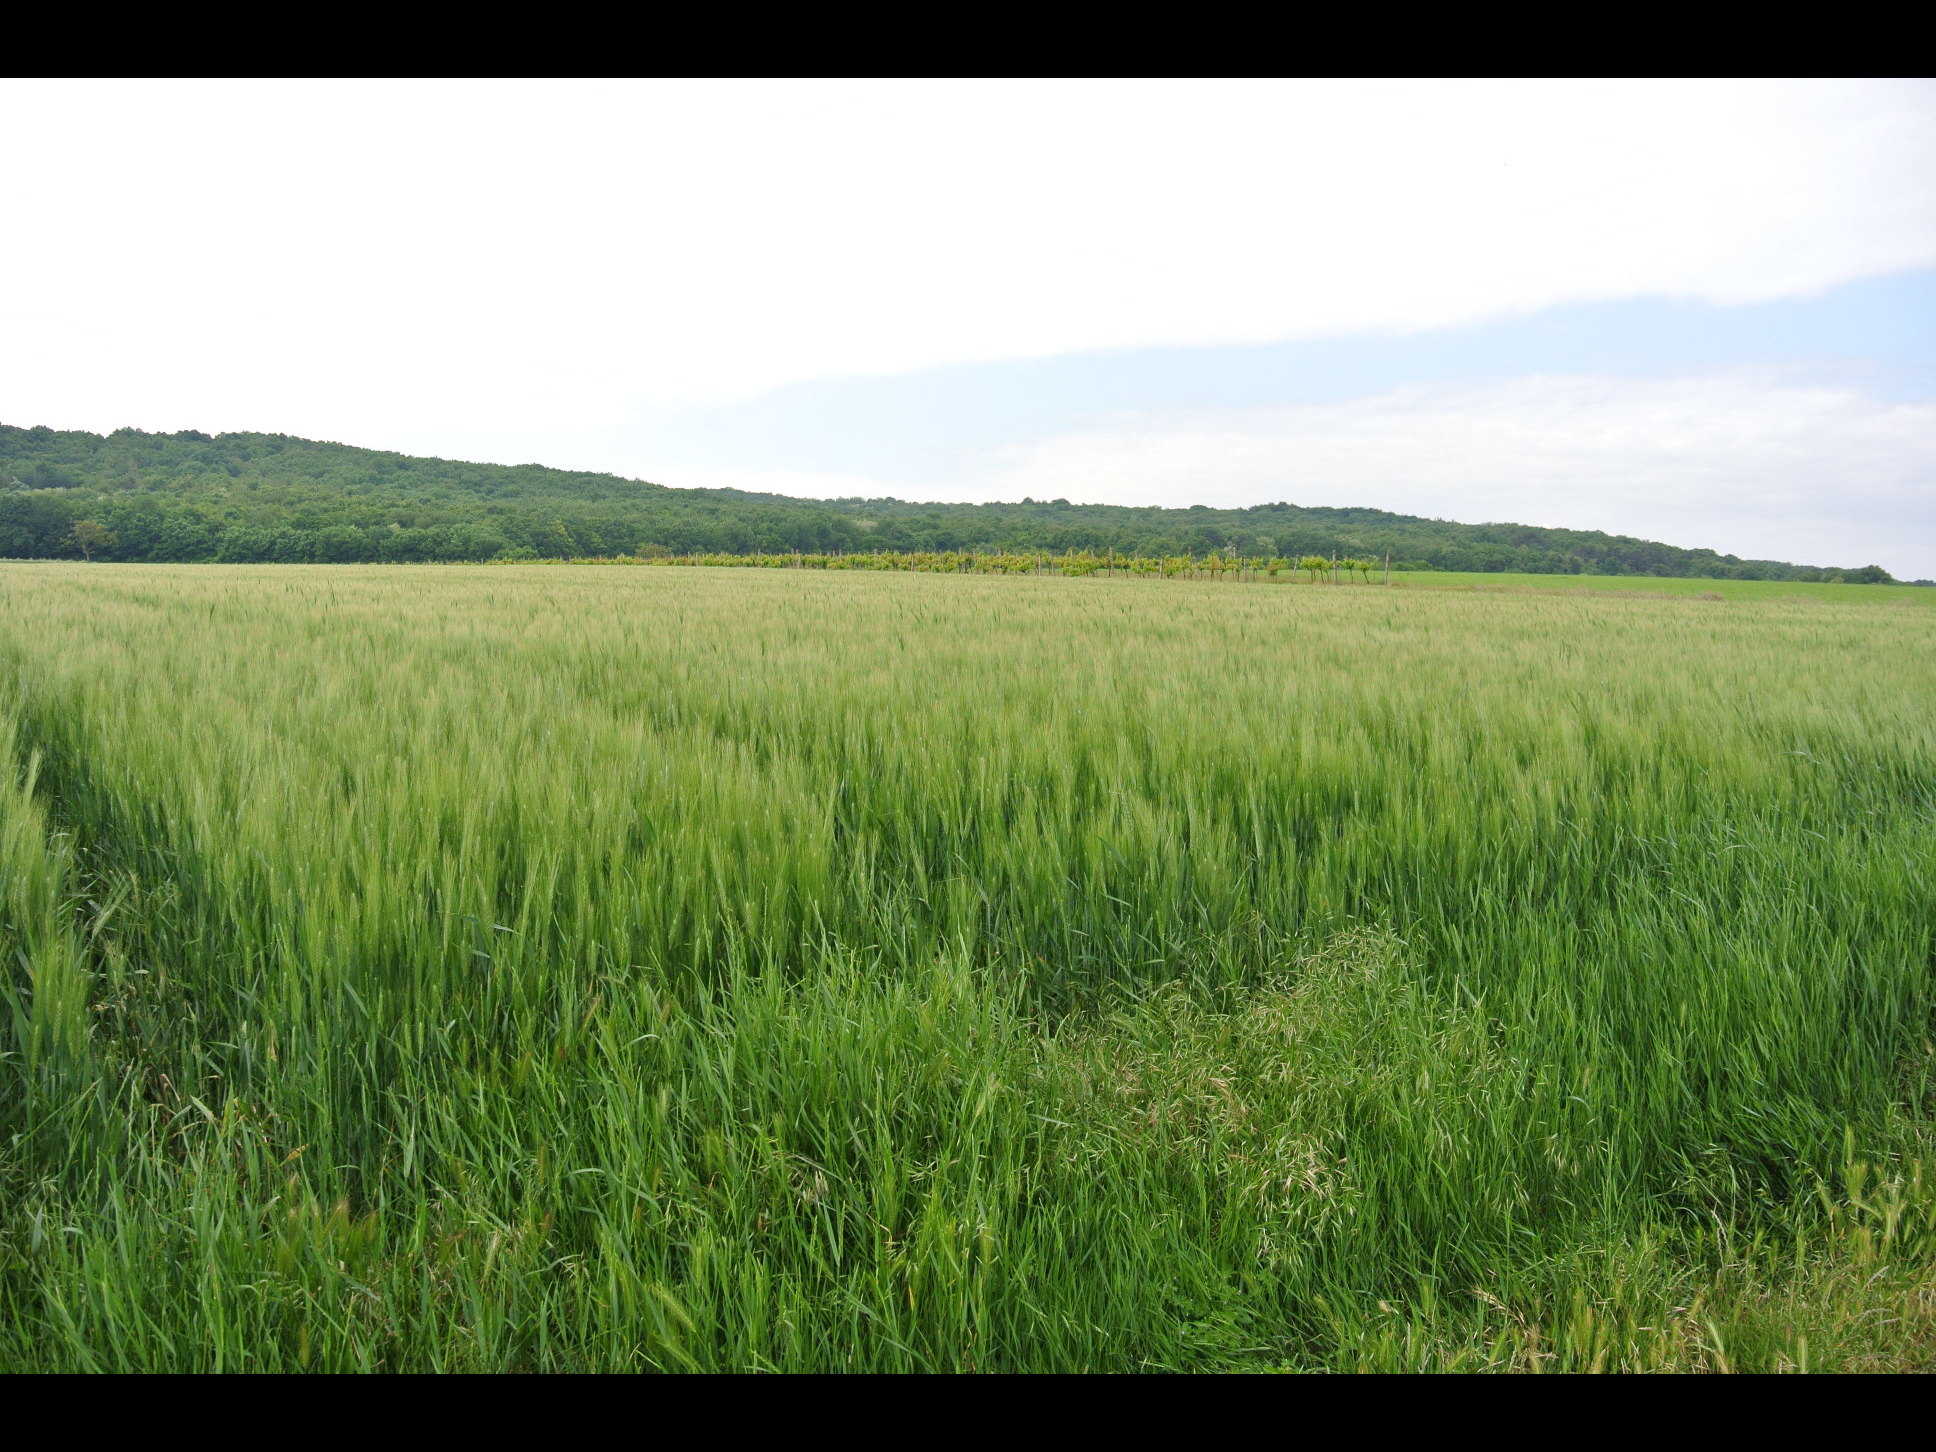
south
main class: Cropland
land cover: Durum wheat
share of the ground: > 75 %
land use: Agriculture (excluding fallow land and kitchen gardens)
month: May
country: AT
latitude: 47.9873
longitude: 16.6382
